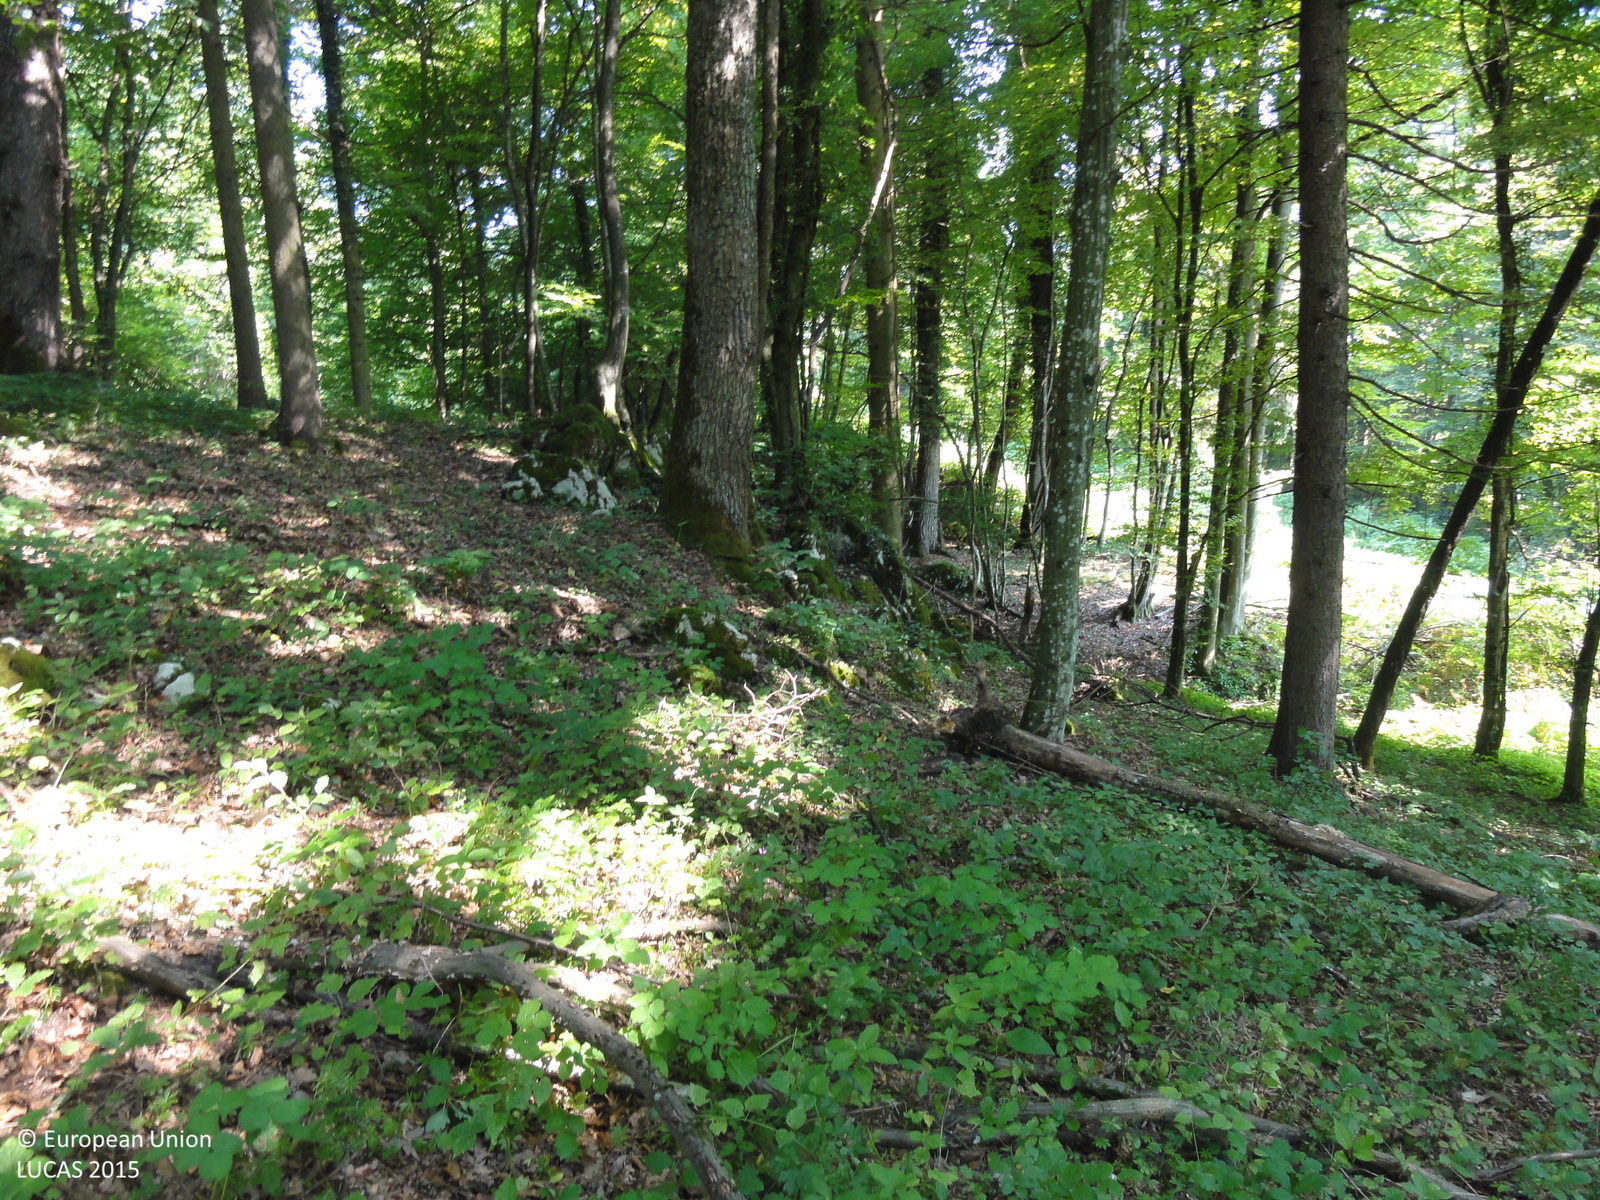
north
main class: Woodland
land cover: Spruce dominated mixed woodland
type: mesophytic deciduous forest
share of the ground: > 75 %
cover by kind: broadleaved forest trees 70 %, coniferous forest trees 30 %
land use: Forestry
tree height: > 5 m
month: August
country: SI
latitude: 45.8451
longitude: 15.2117
